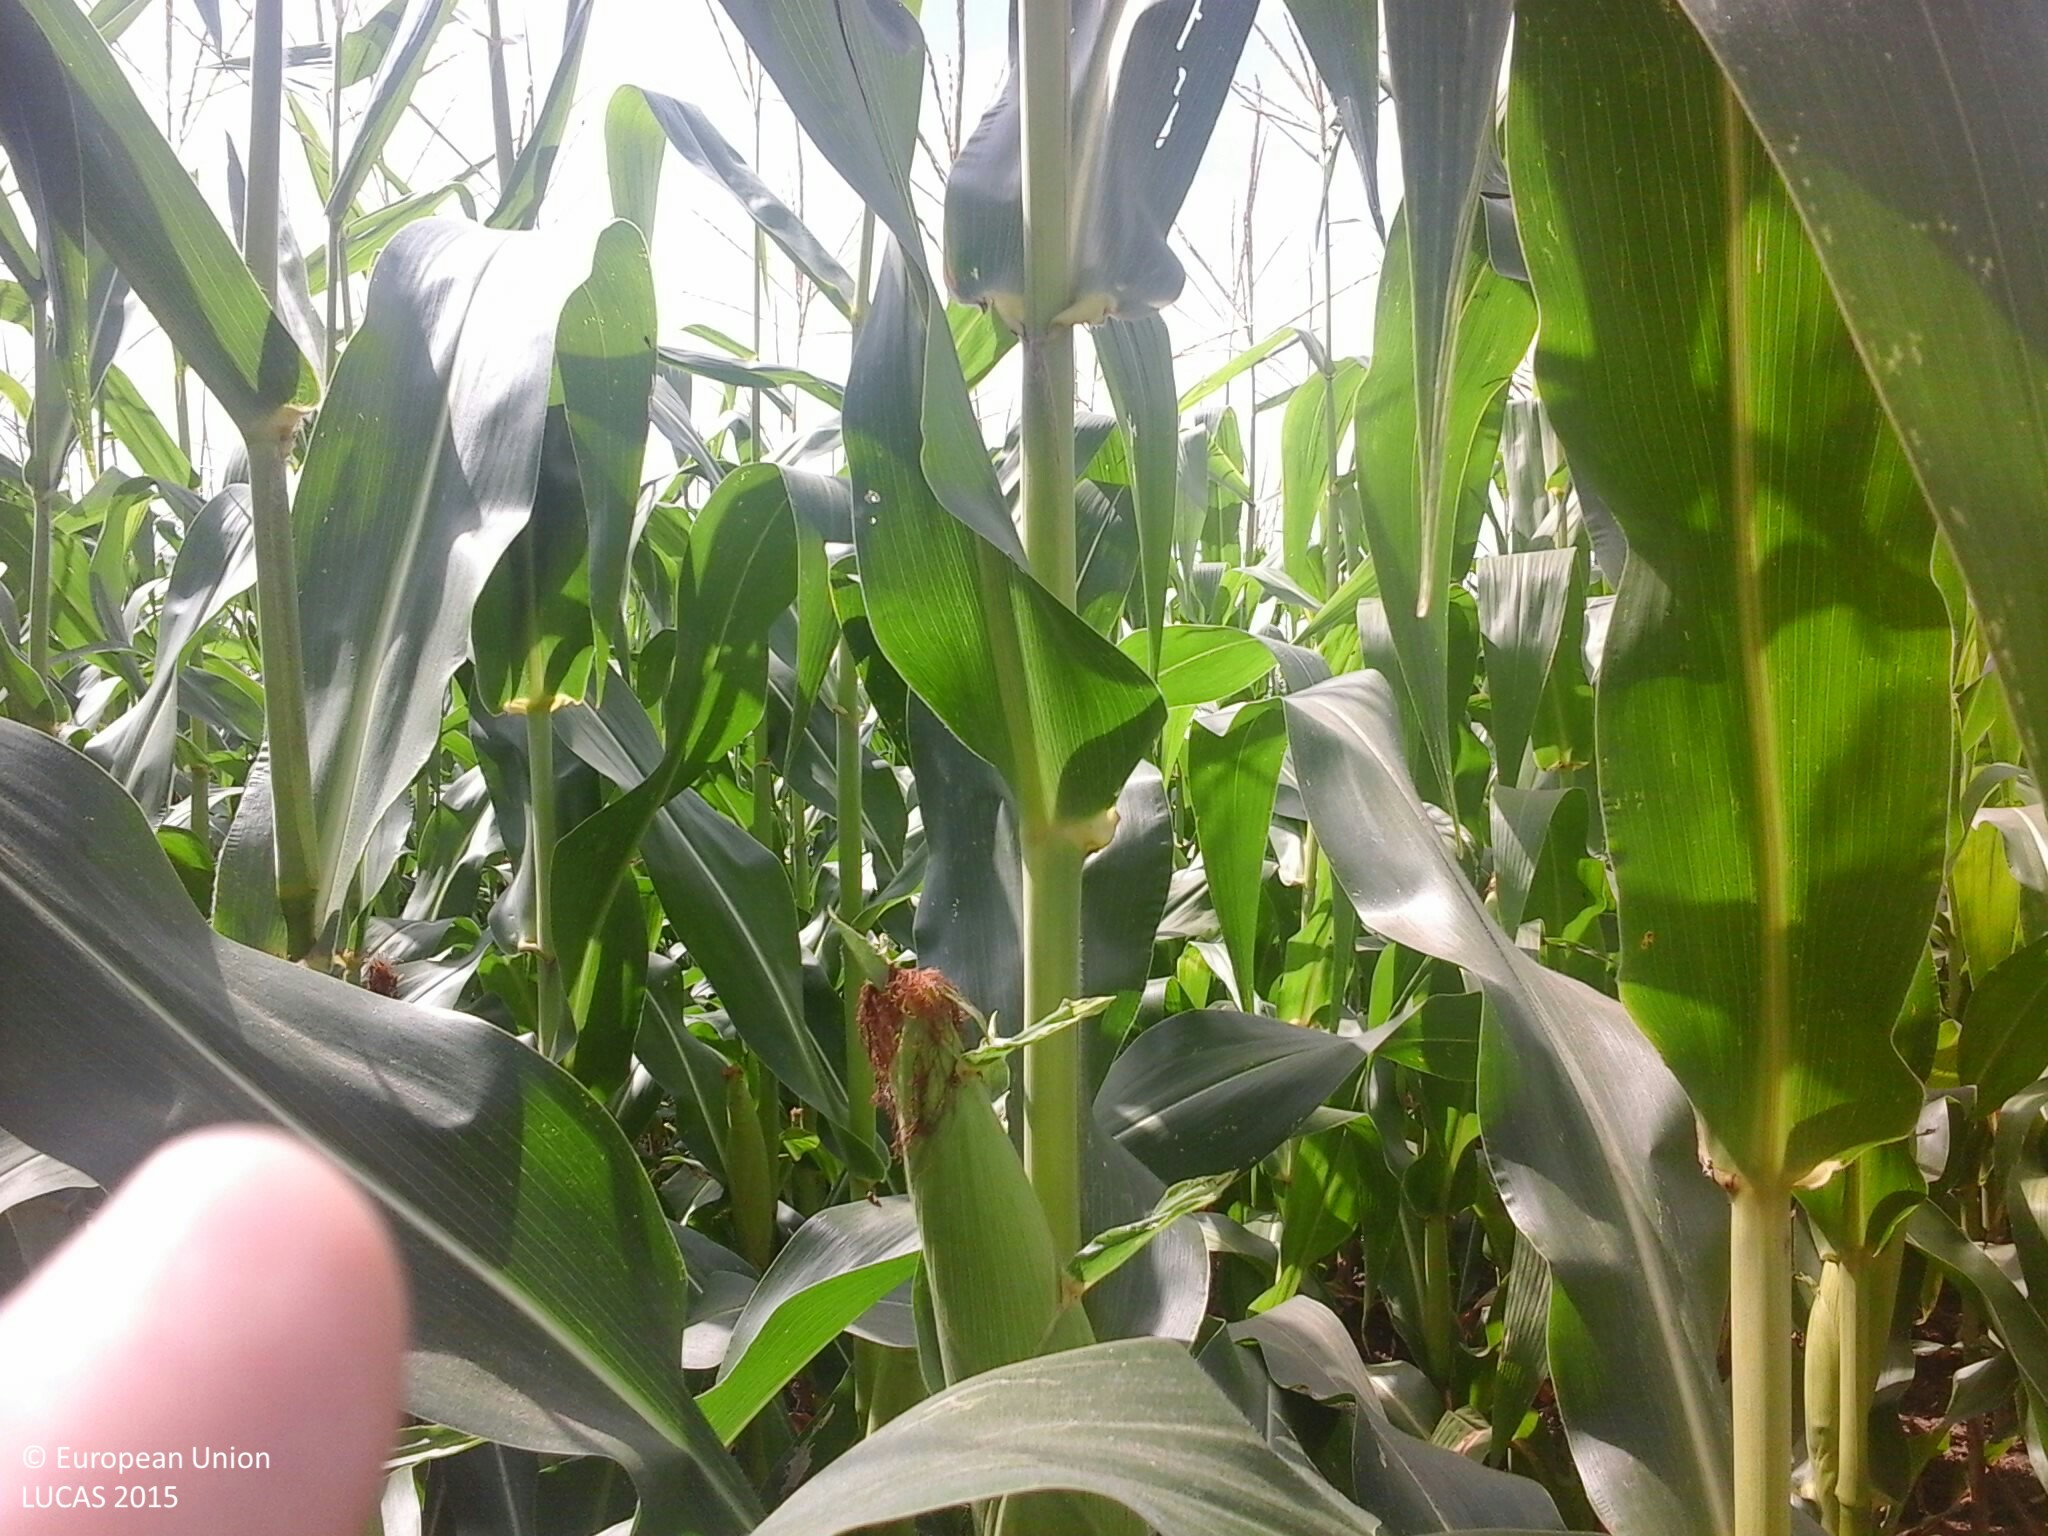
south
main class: Cropland
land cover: Maize
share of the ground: > 75 %
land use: Agriculture (excluding fallow land and kitchen gardens)
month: July
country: HU
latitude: 48.2801
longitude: 22.2797
